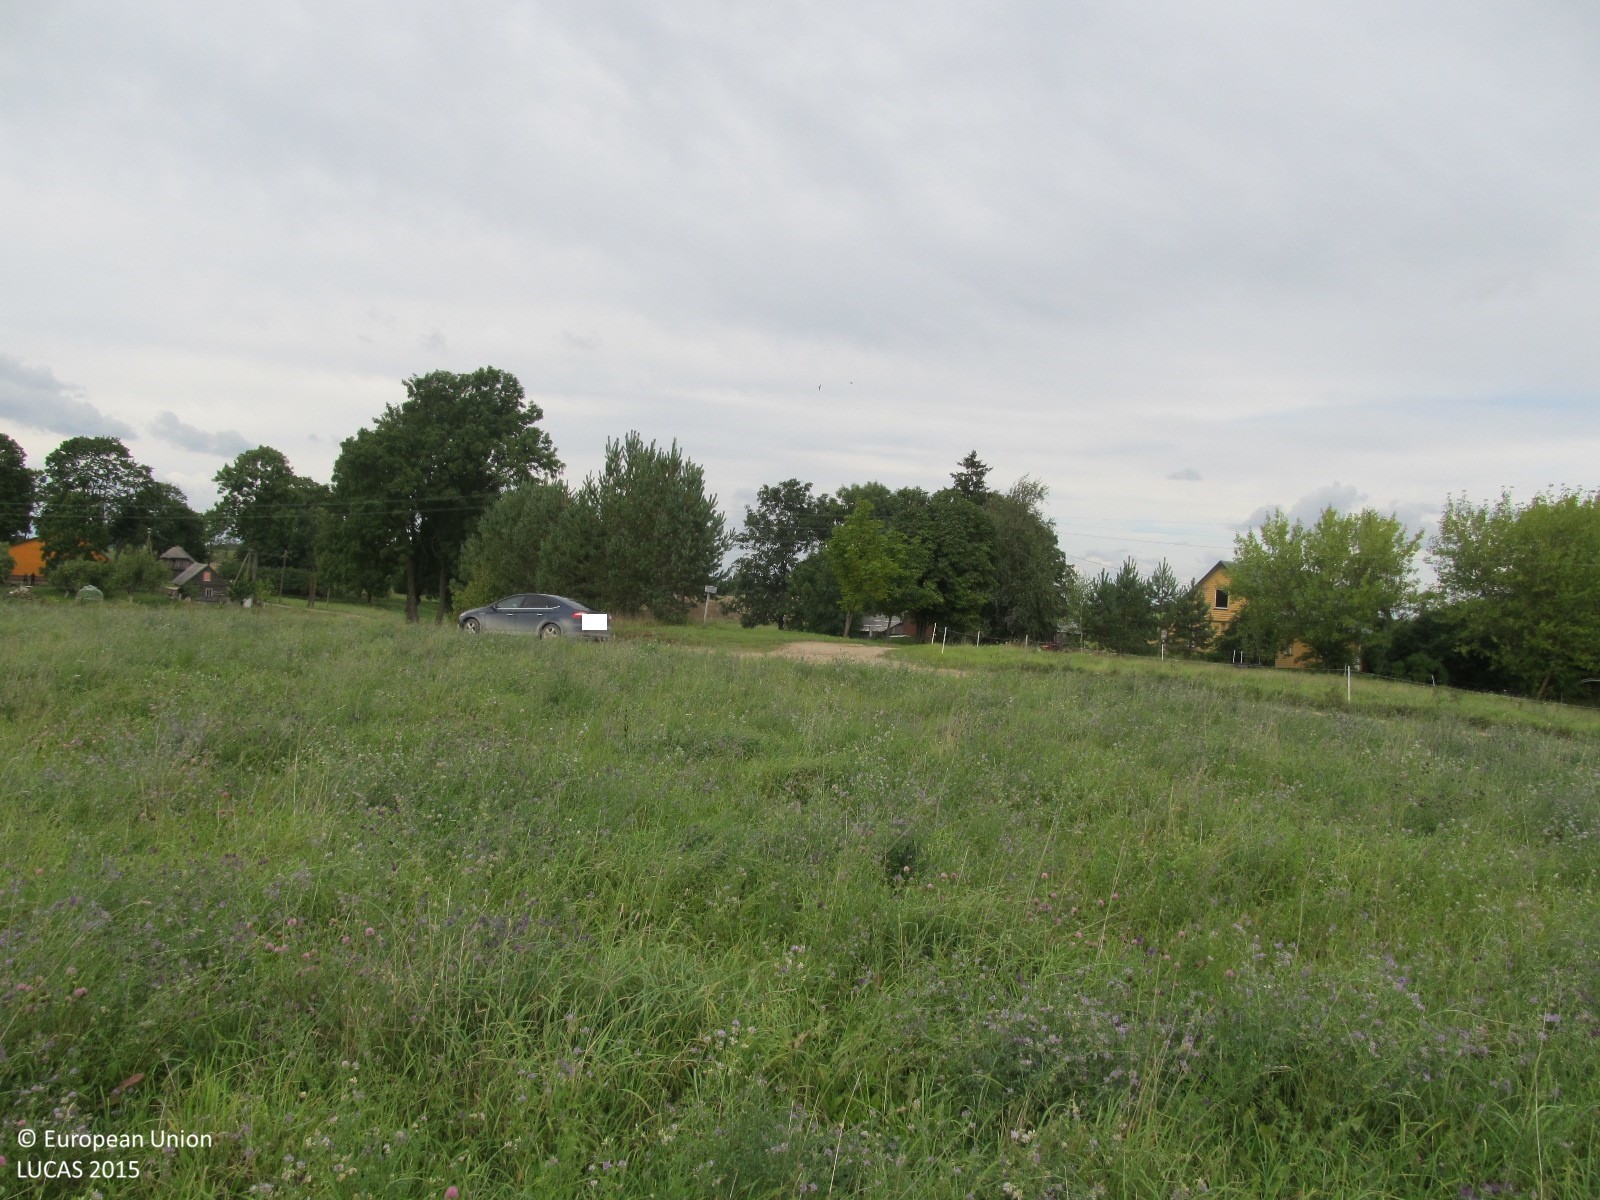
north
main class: Grassland
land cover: Grassland without tree/shrub cover
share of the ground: > 75 %
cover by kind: herbaceous plants 100 %
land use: Agriculture (excluding fallow land and kitchen gardens)
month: September
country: LT
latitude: 55.7043
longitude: 22.6502
